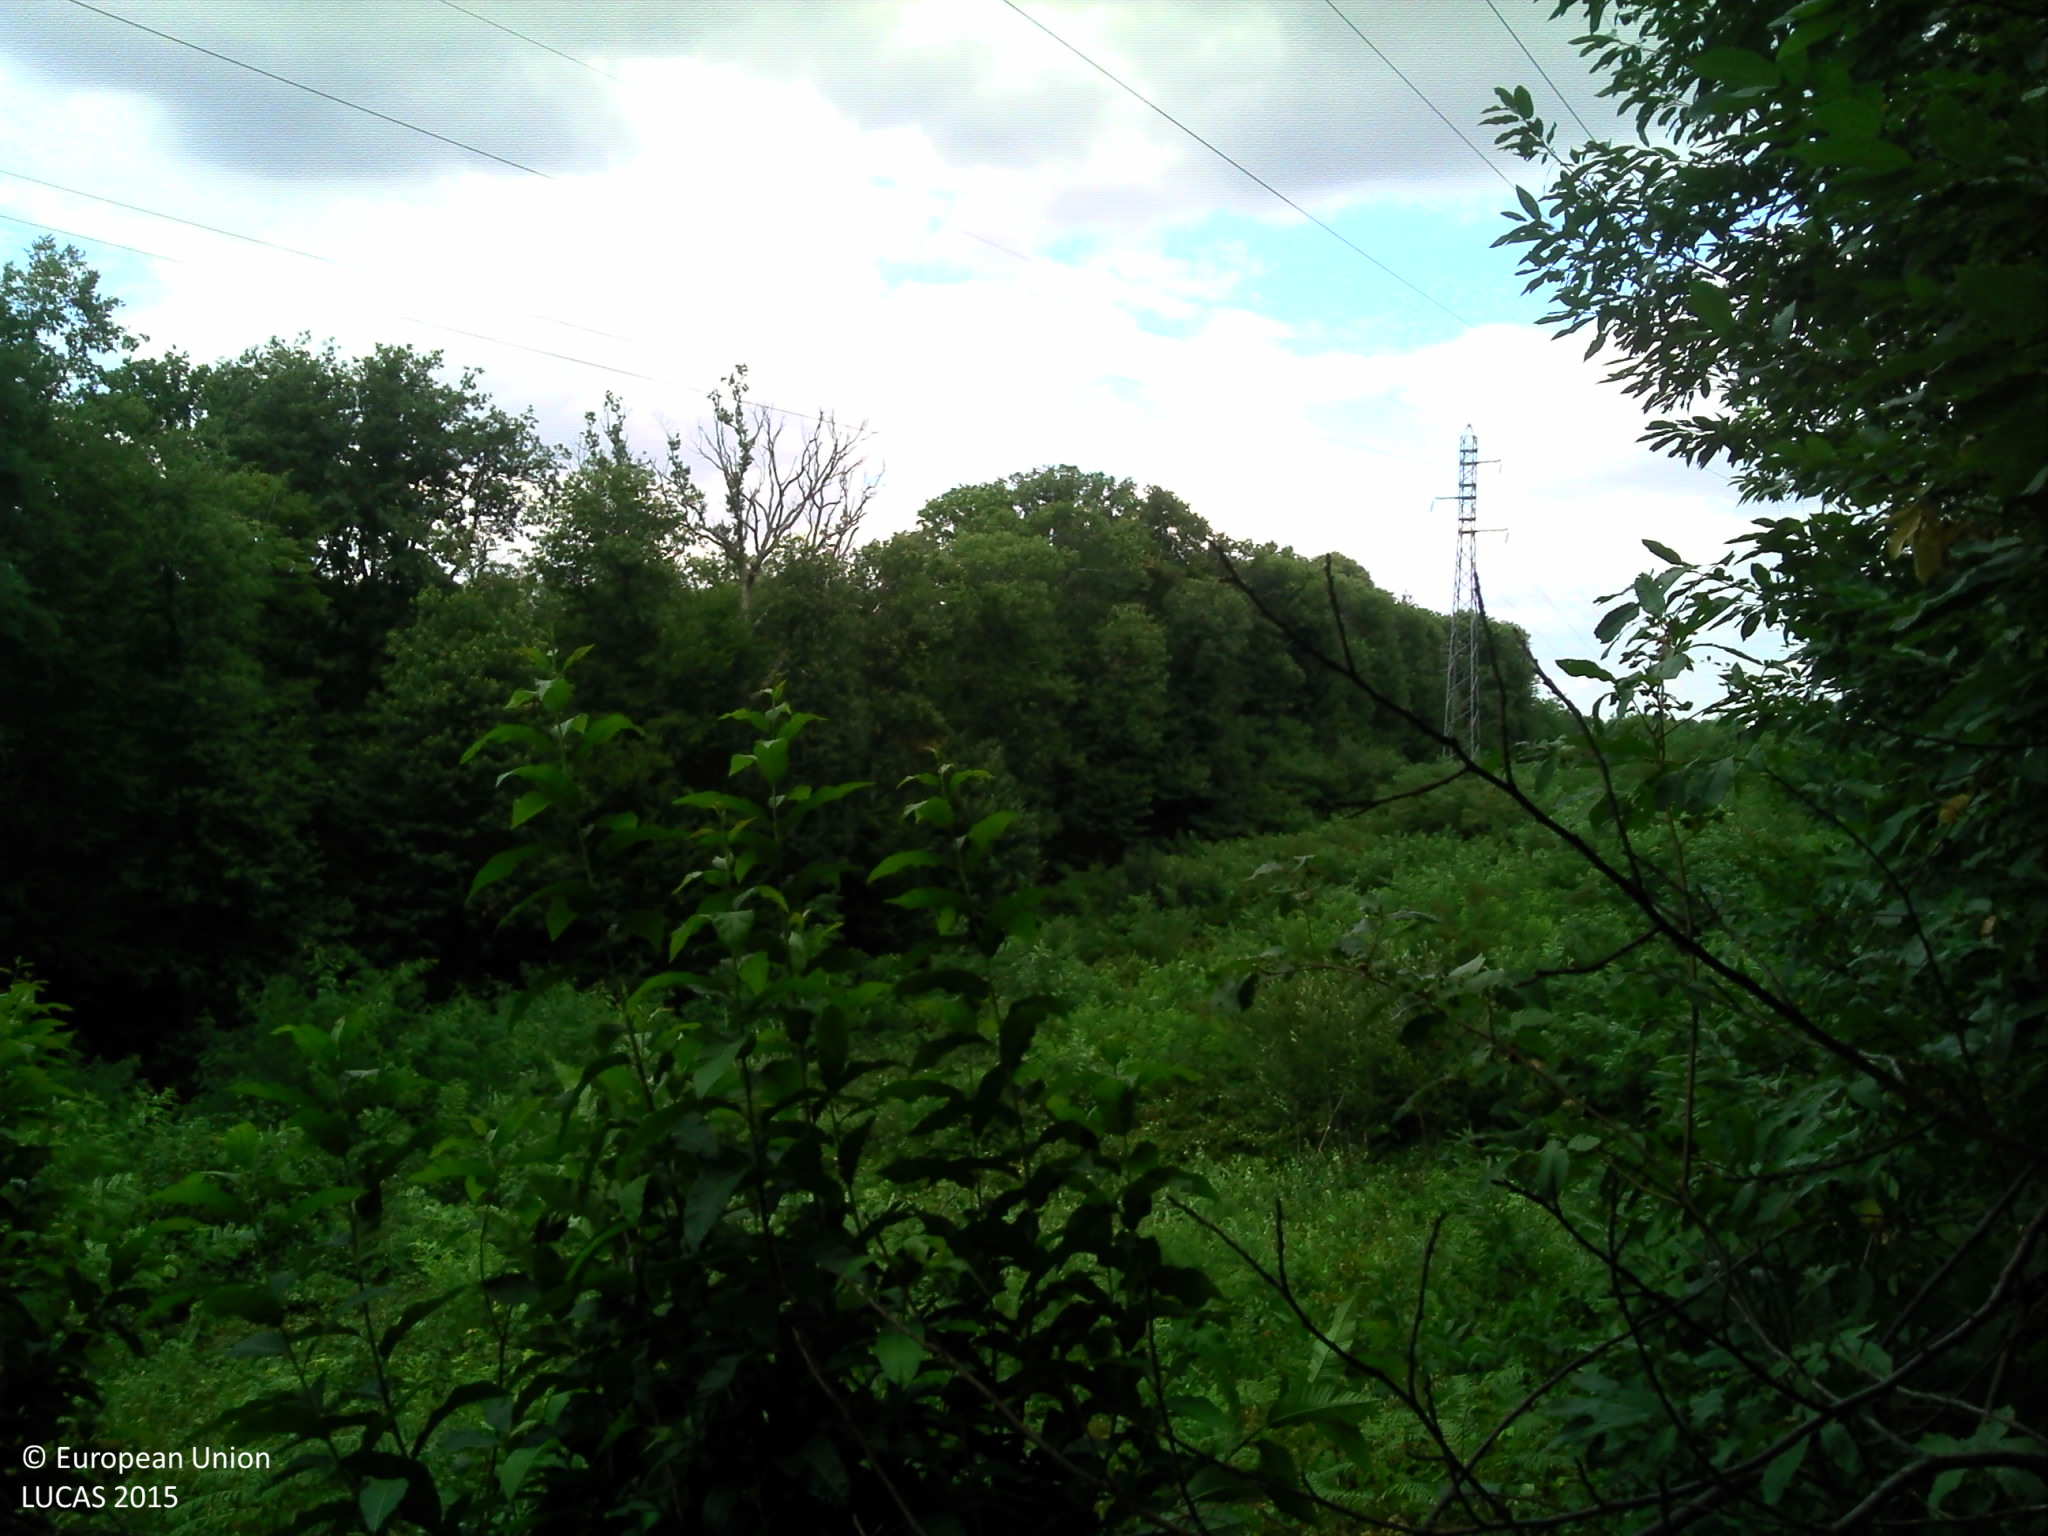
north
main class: Woodland
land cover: Broadleaved woodland
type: thermophilous deciduous forest
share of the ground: > 75 %
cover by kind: broadleaved forest trees 55 %, lichens and mosses 15 %, shrubs 10 %, herbaceous plants 10 %
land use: Forestry
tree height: > 5 m
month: July
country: FR
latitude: 48.4190
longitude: 2.7618
